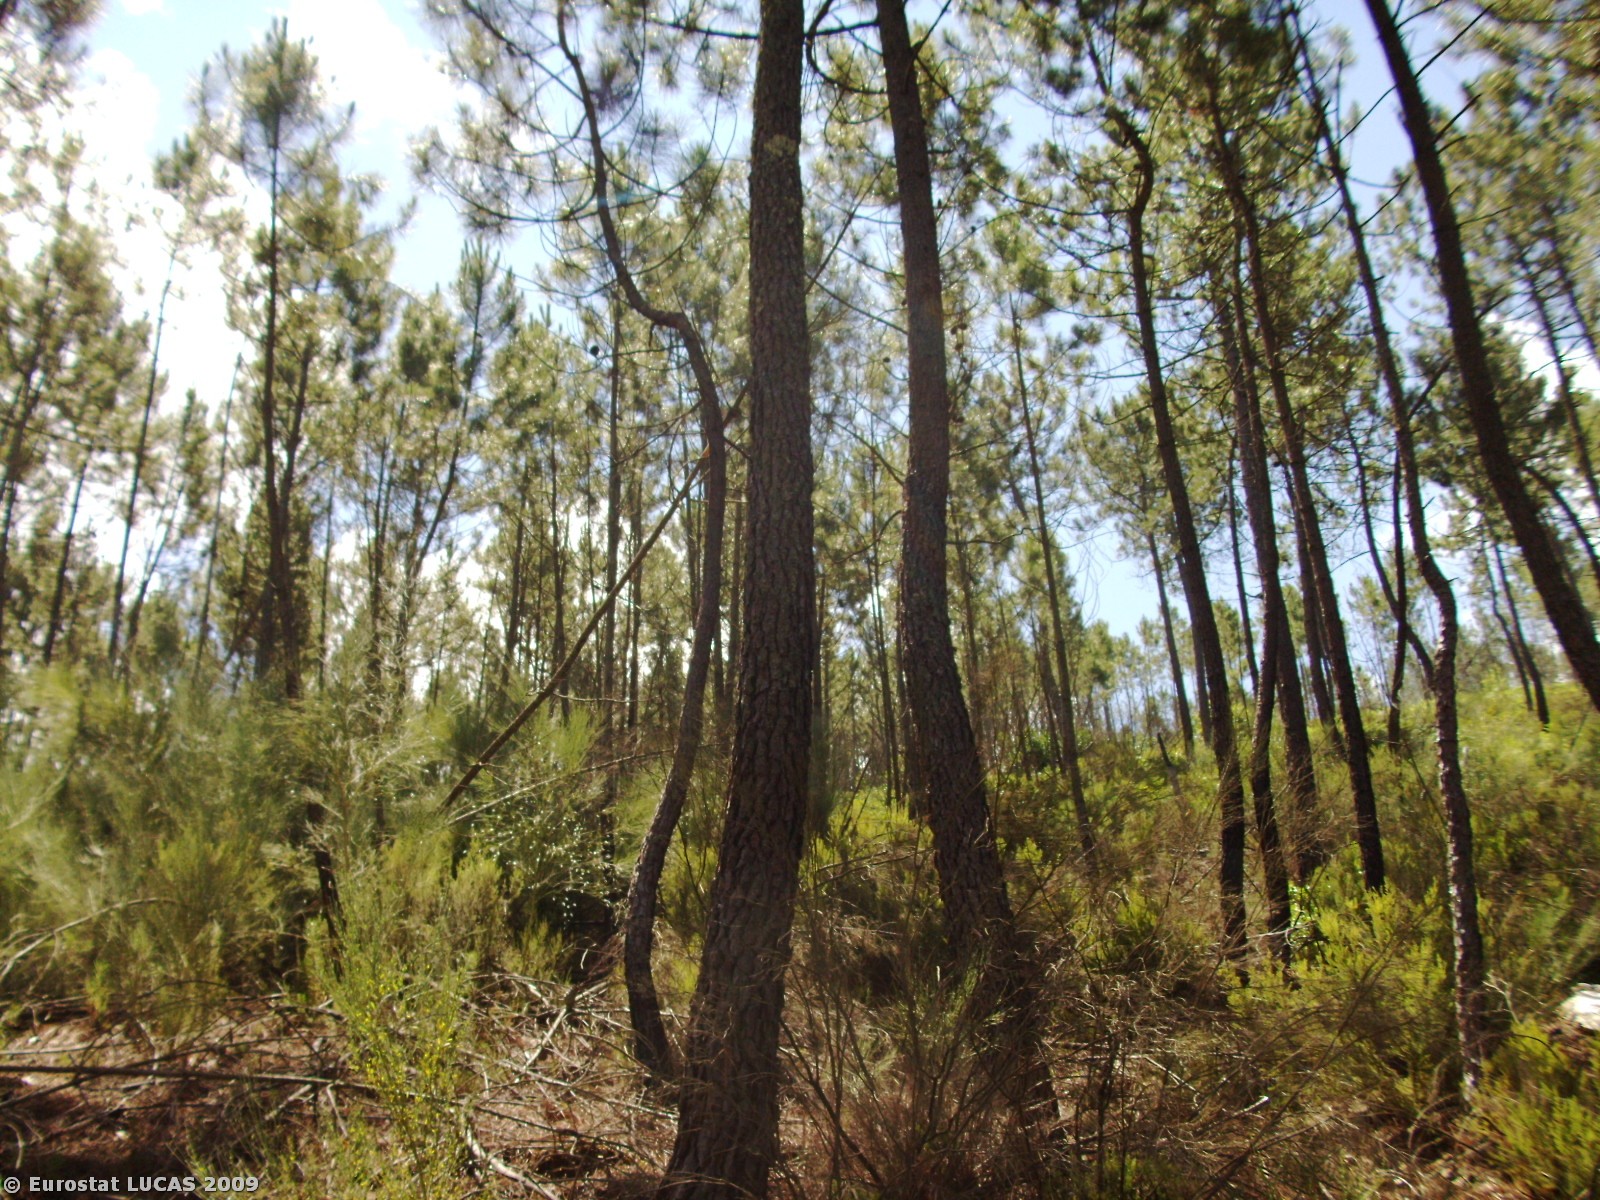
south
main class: Woodland
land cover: Coniferous woodland
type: coniferous forest of the mediterranean region
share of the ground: > 75 %
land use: Forestry
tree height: > 5 m
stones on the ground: 25 - 50 %
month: June
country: PT
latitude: 40.2832
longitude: -7.7206
